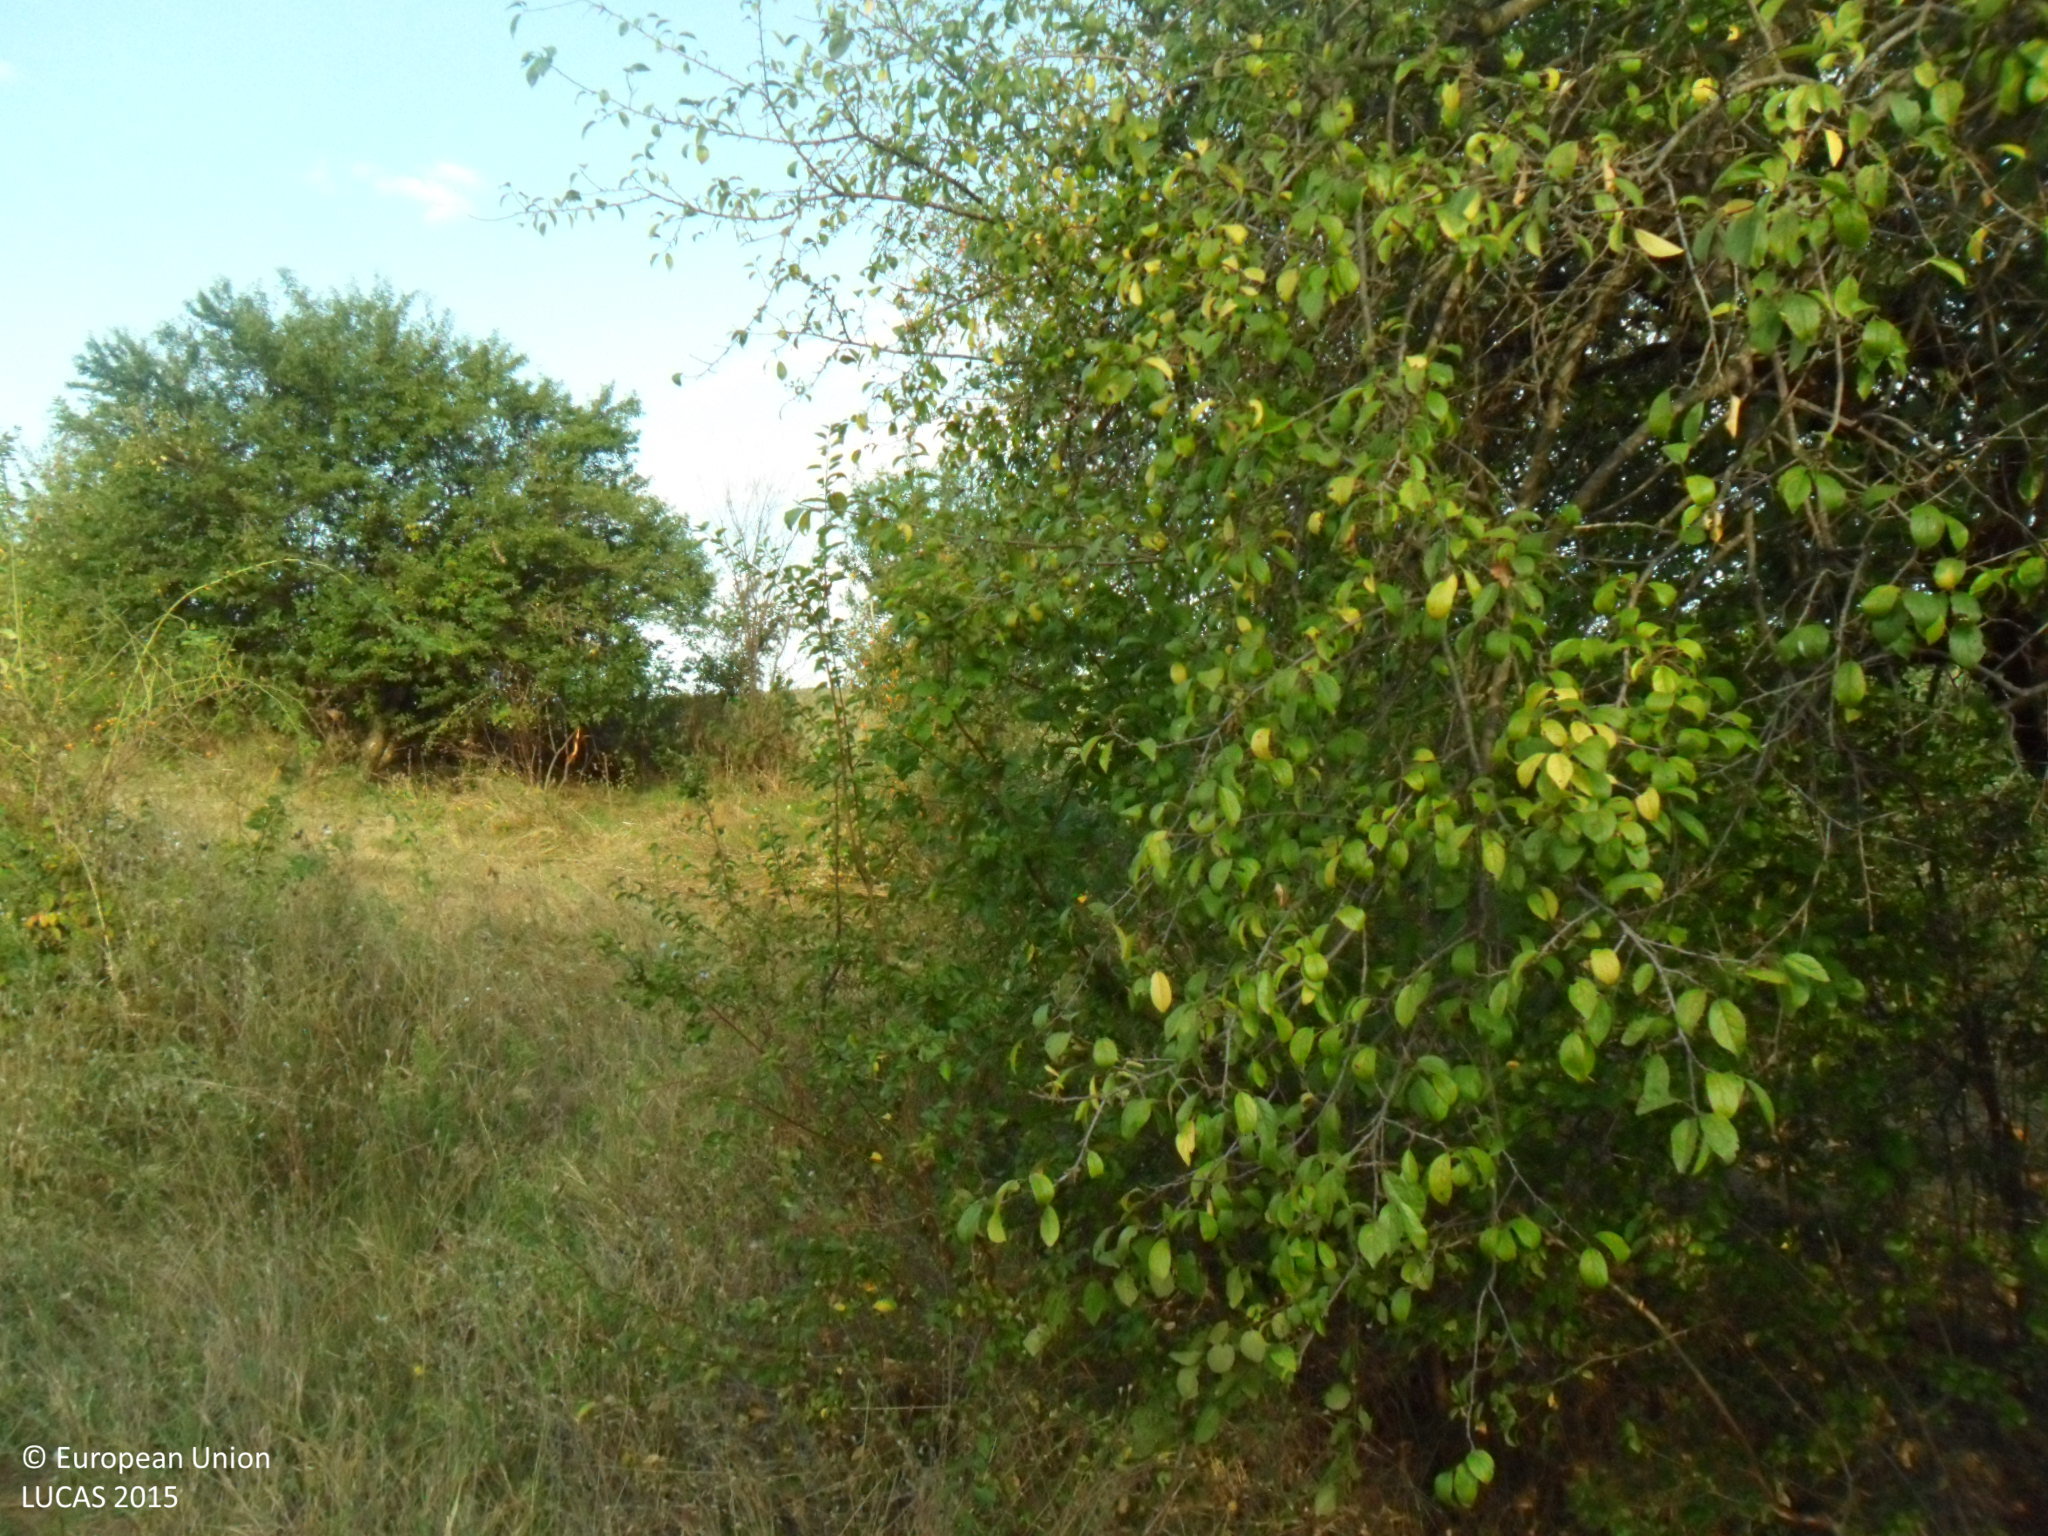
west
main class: Shrubland
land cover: Shrubland with sparse tree cover
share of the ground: > 75 %
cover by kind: shrubs 80 %, herbaceous plants 15 %, broadleaved forest trees 5 %
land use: Agriculture (excluding fallow land and kitchen gardens)
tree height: < 5 m
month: September
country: BG
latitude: 43.6289
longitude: 26.2492
